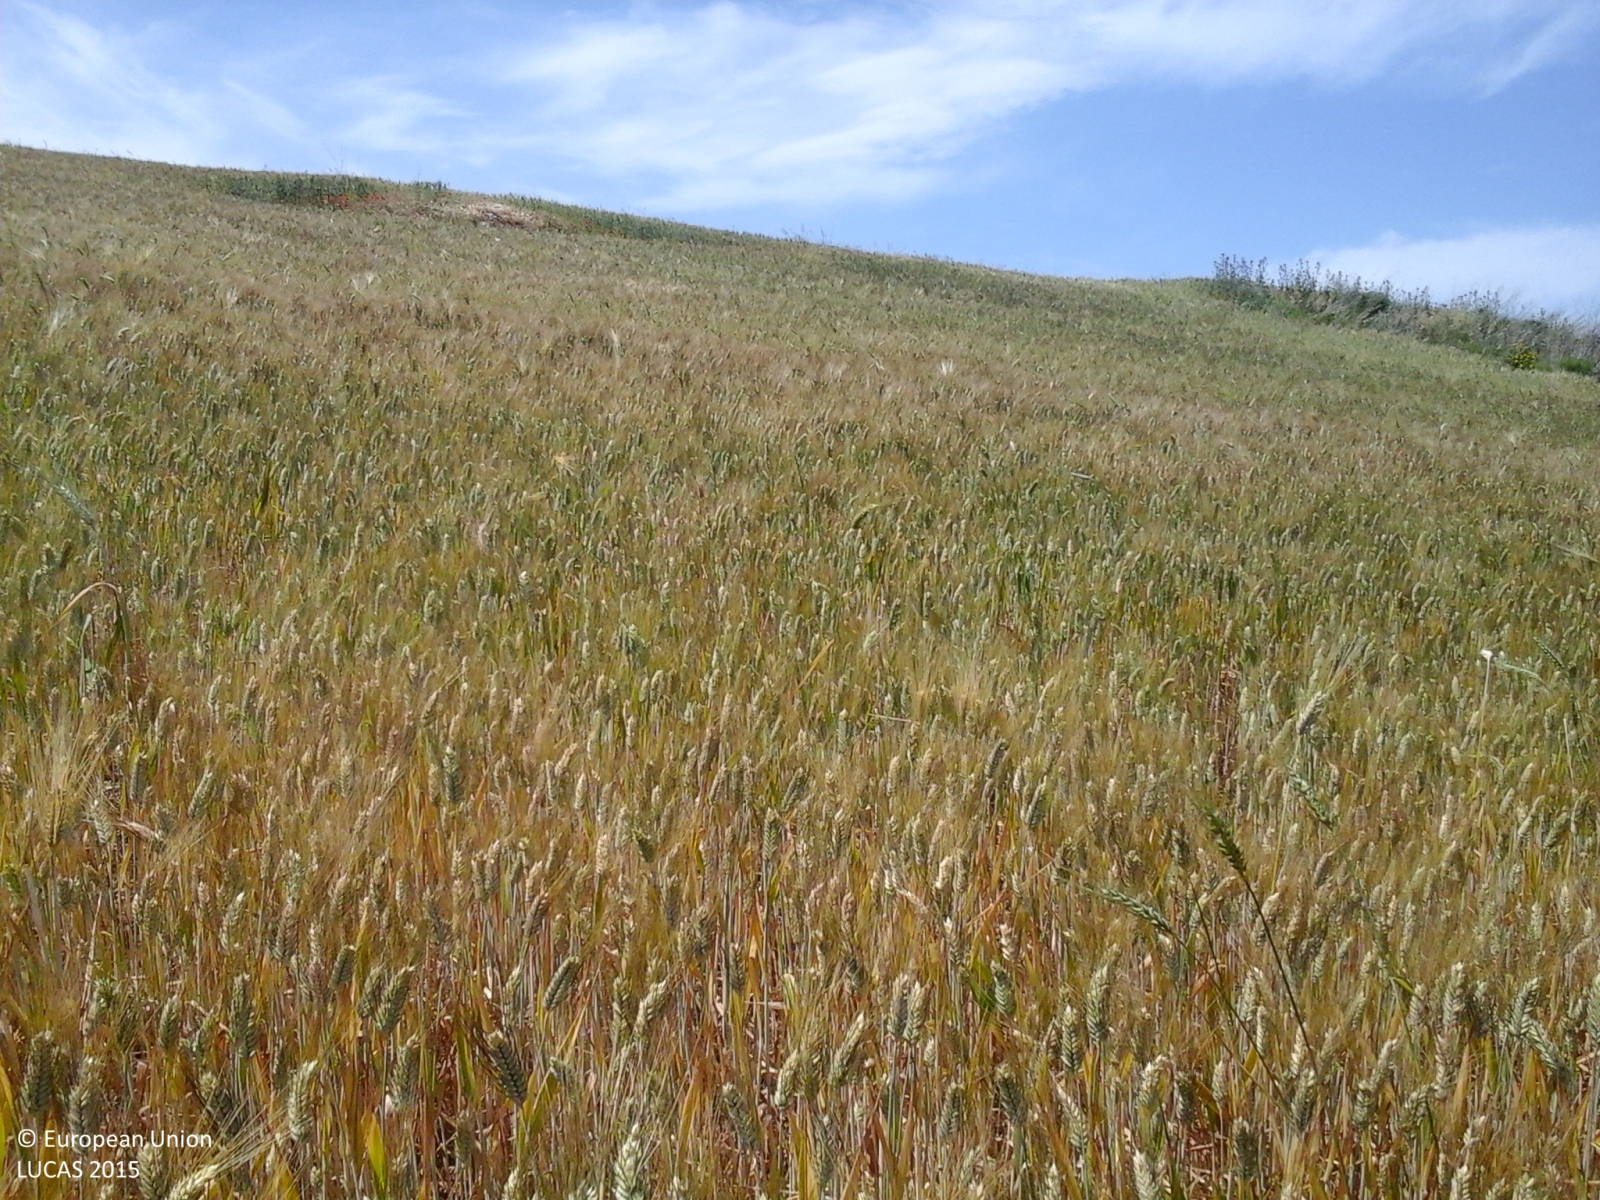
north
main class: Cropland
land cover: Durum wheat
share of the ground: > 75 %
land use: Agriculture (excluding fallow land and kitchen gardens)
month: May
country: IT
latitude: 37.8809
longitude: 13.5558
